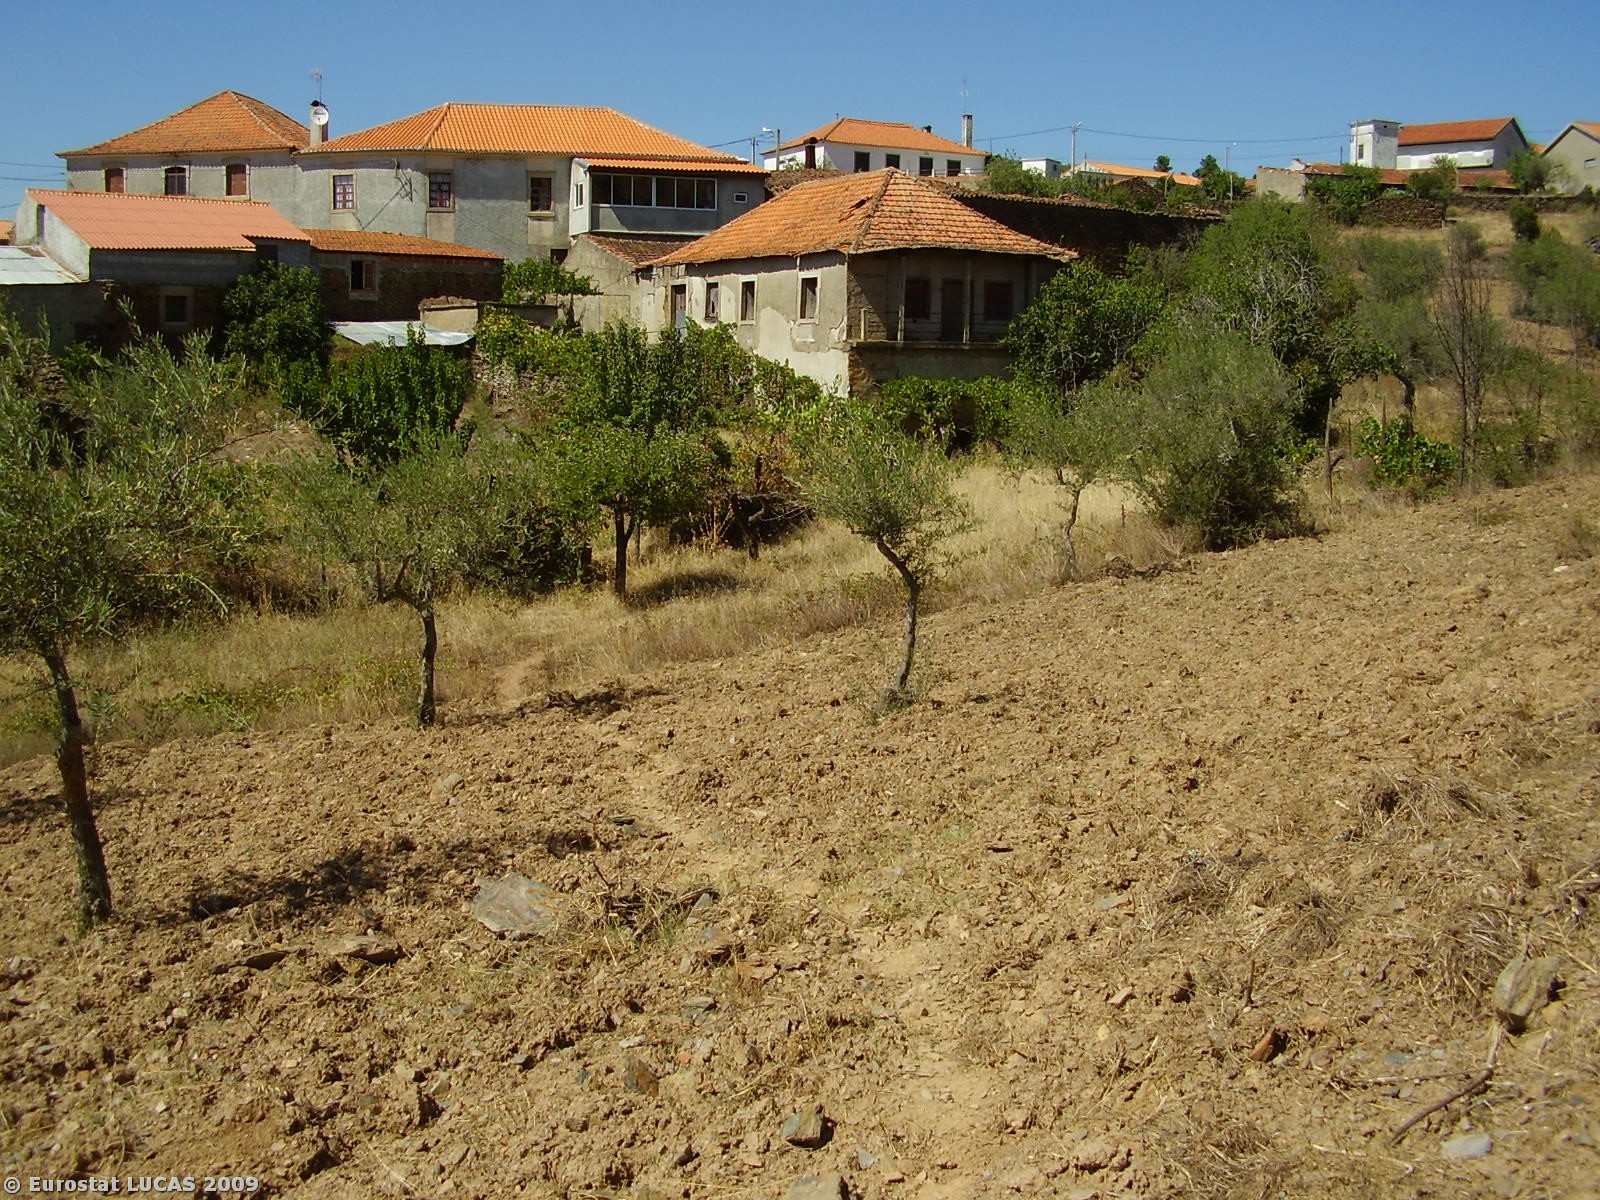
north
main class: Cropland
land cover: Olive groves
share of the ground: 10 - 25 %
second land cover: Spontaneously vegetated surfaces
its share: 10 - 25 %
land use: Agriculture (excluding fallow land and kitchen gardens)
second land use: Fallow land
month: August
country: PT
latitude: 41.2432
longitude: -6.7749
